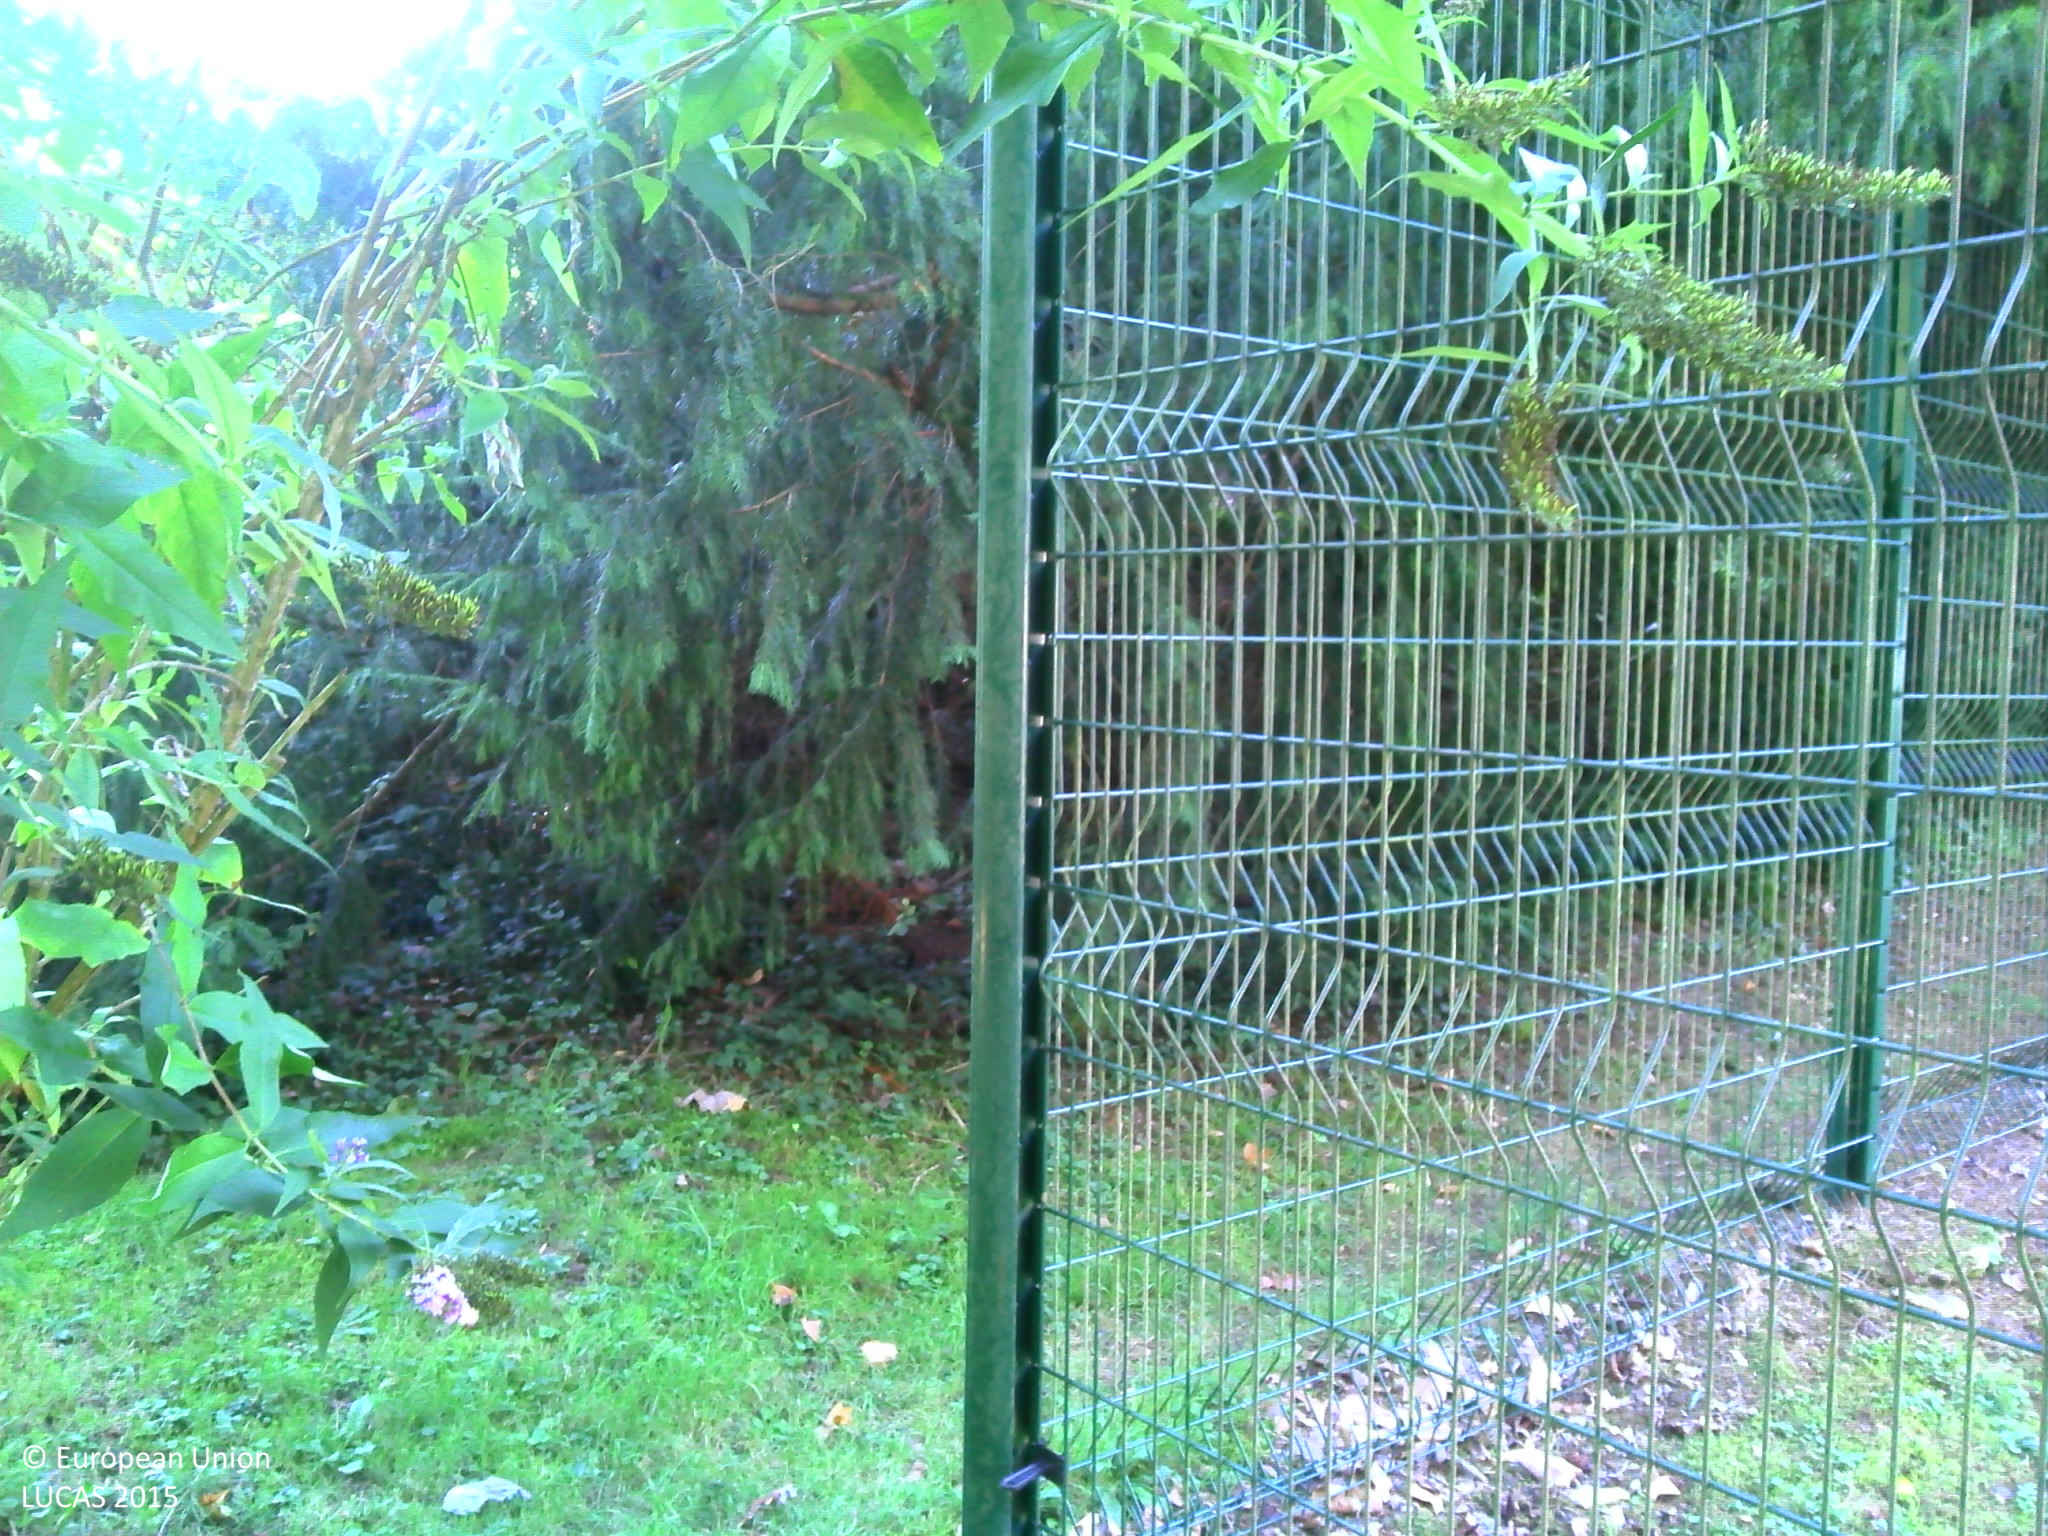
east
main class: Grassland
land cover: Grassland without tree/shrub cover
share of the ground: > 75 %
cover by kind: herbaceous plants 70 %, consolidated bare surface 10 %
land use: Amenities, museums, leisure
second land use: Sport
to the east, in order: Grassland without tree/shrub cover; Broadleaved woodland; Artificial constructions in urban areas
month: September
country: FR
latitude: 47.3228
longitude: 6.0191
